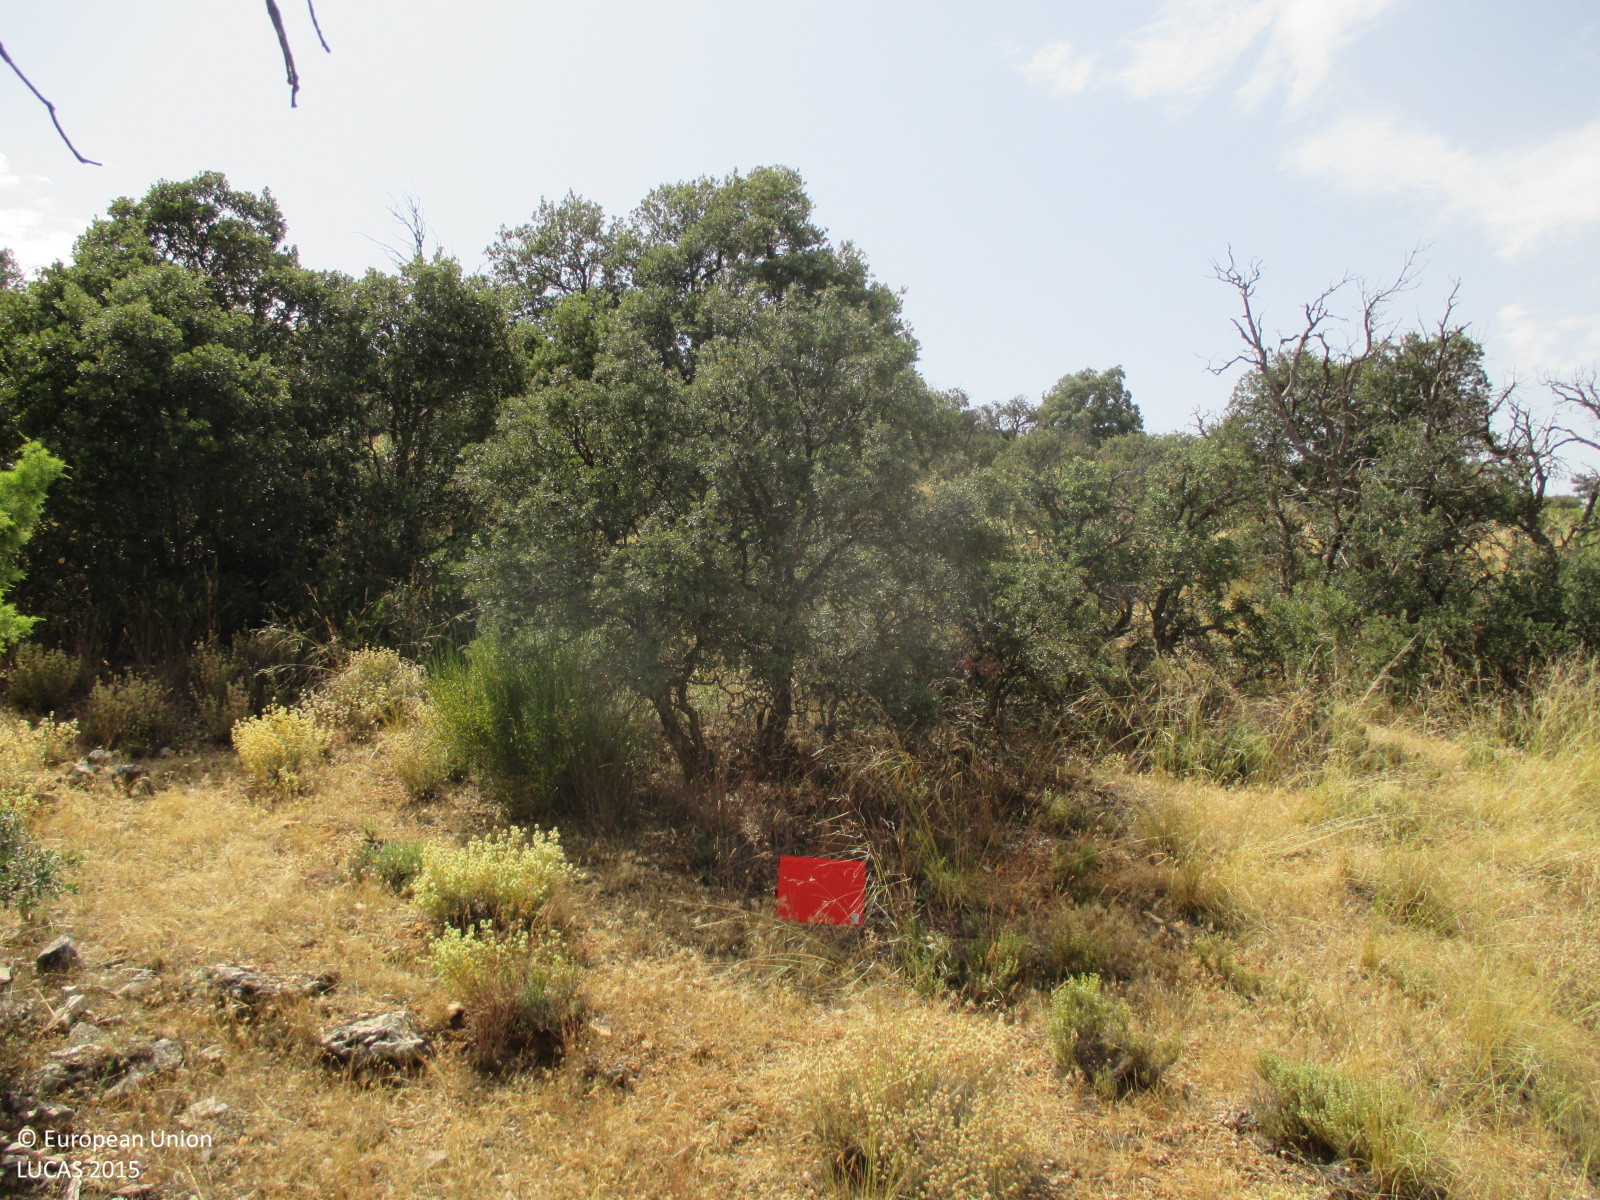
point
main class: Woodland
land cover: Broadleaved woodland
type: broadleaved evergreen forest
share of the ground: 50 - 75 %
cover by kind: broadleaved forest trees 60 %, shrubs 20 %, herbaceous plants 20 %
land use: Semi-natural and natural areas not in use
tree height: < 5 m
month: June
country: ES
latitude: 37.6326
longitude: -2.3716
